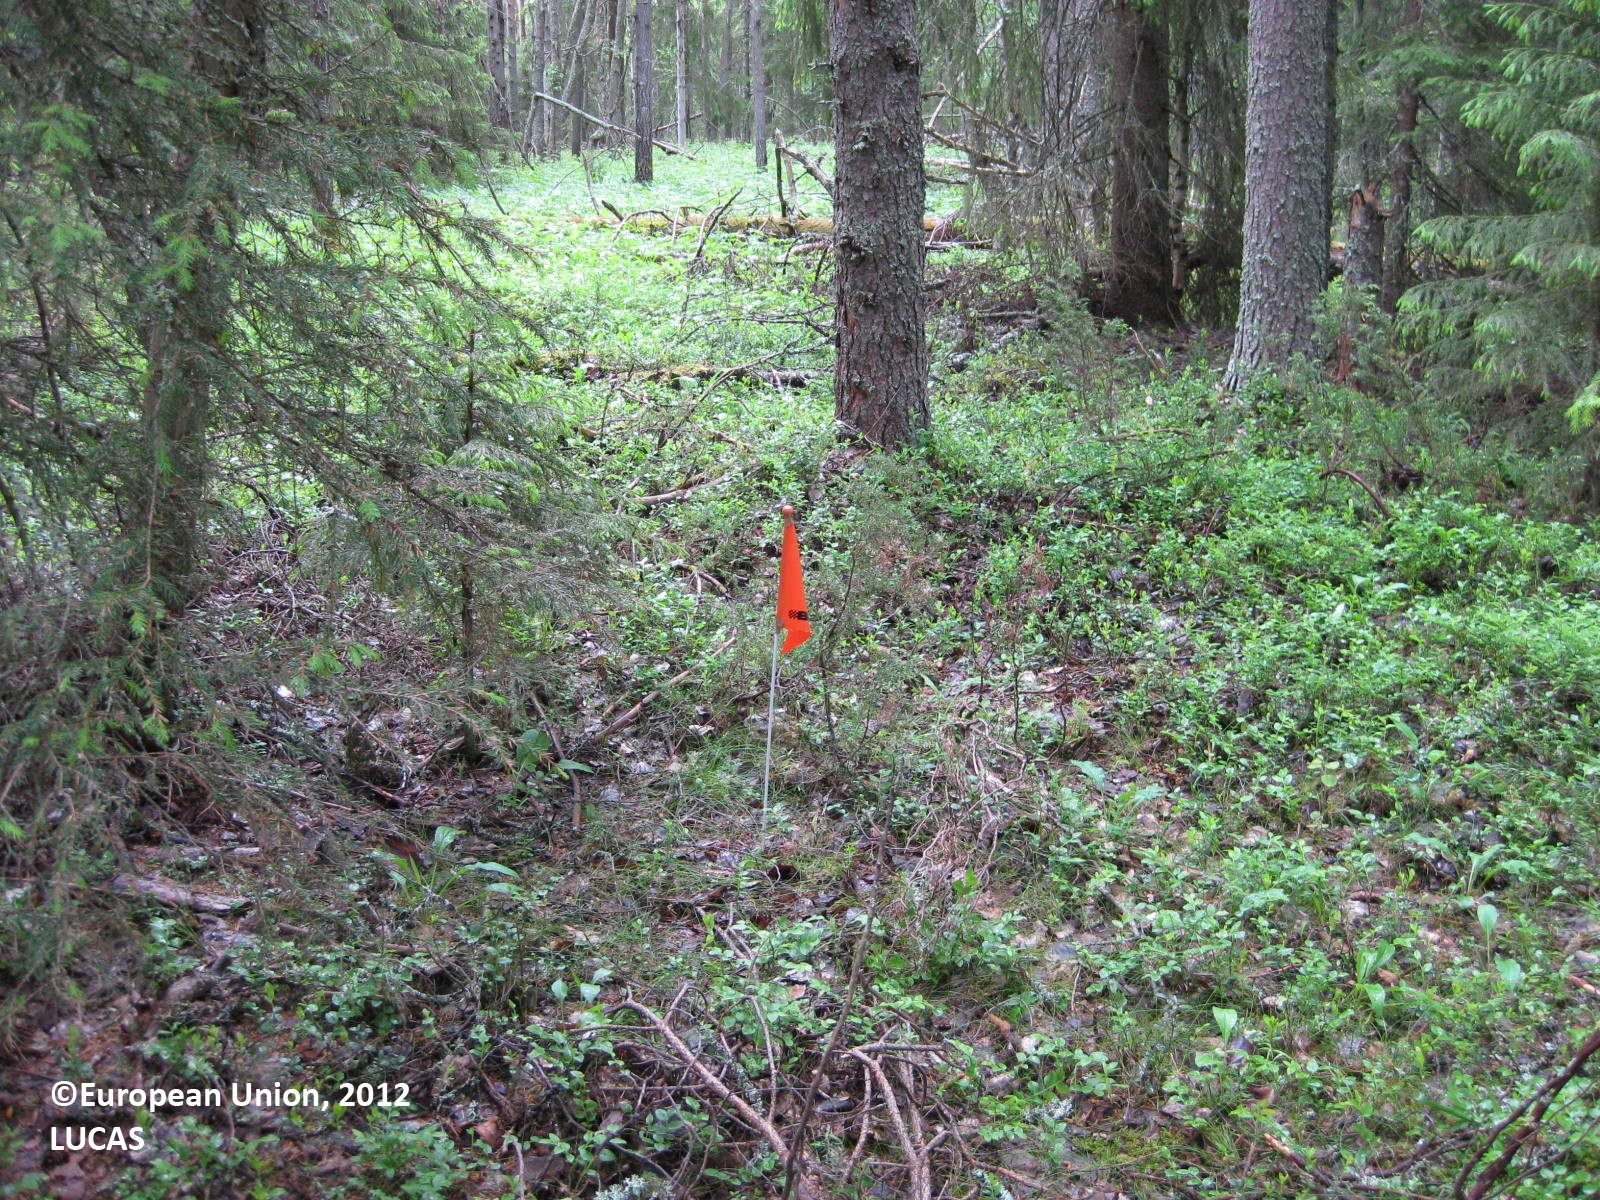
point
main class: Woodland
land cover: Other coniferous woodland
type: boreal forest
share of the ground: > 75 %
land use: Forestry
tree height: > 5 m
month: June
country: FI
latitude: 65.2357
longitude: 28.1912
